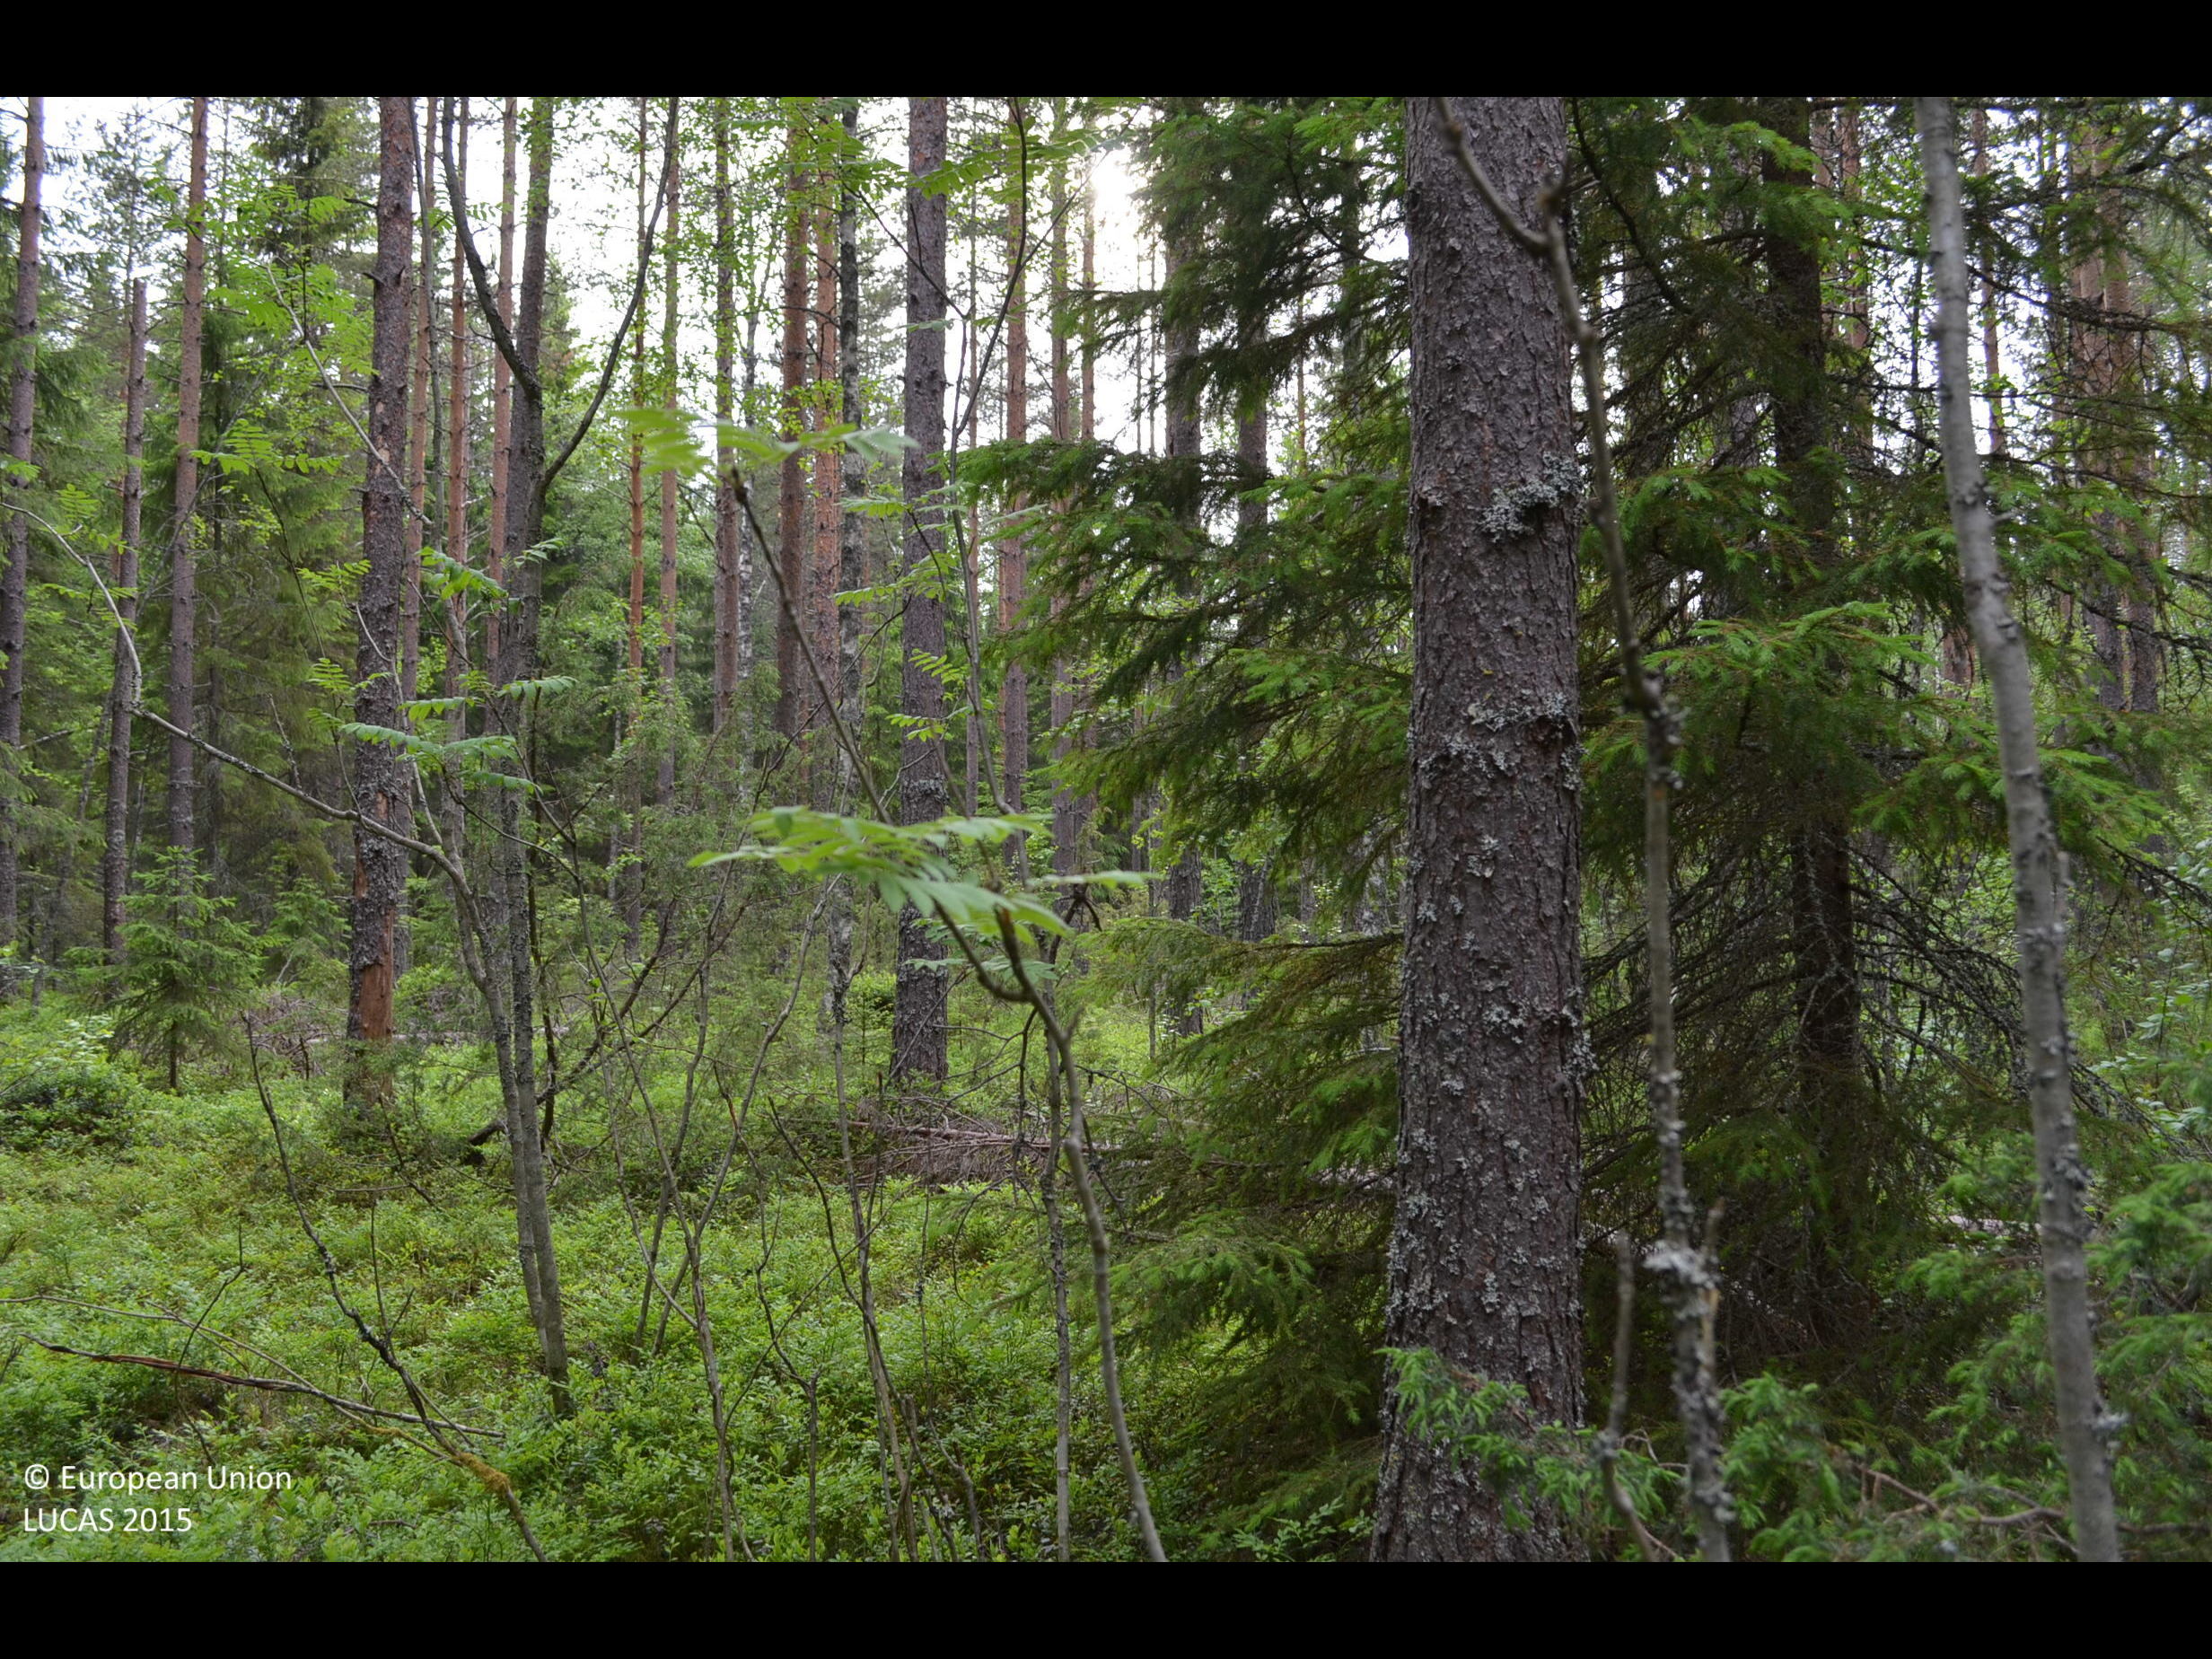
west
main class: Woodland
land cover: Other coniferous woodland
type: boreal forest
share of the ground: > 75 %
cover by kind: coniferous forest trees 60 %, broadleaved forest trees 20 %, shrubs 20 %
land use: Forestry
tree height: > 5 m
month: June
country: FI
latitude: 62.0924
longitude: 23.5000
